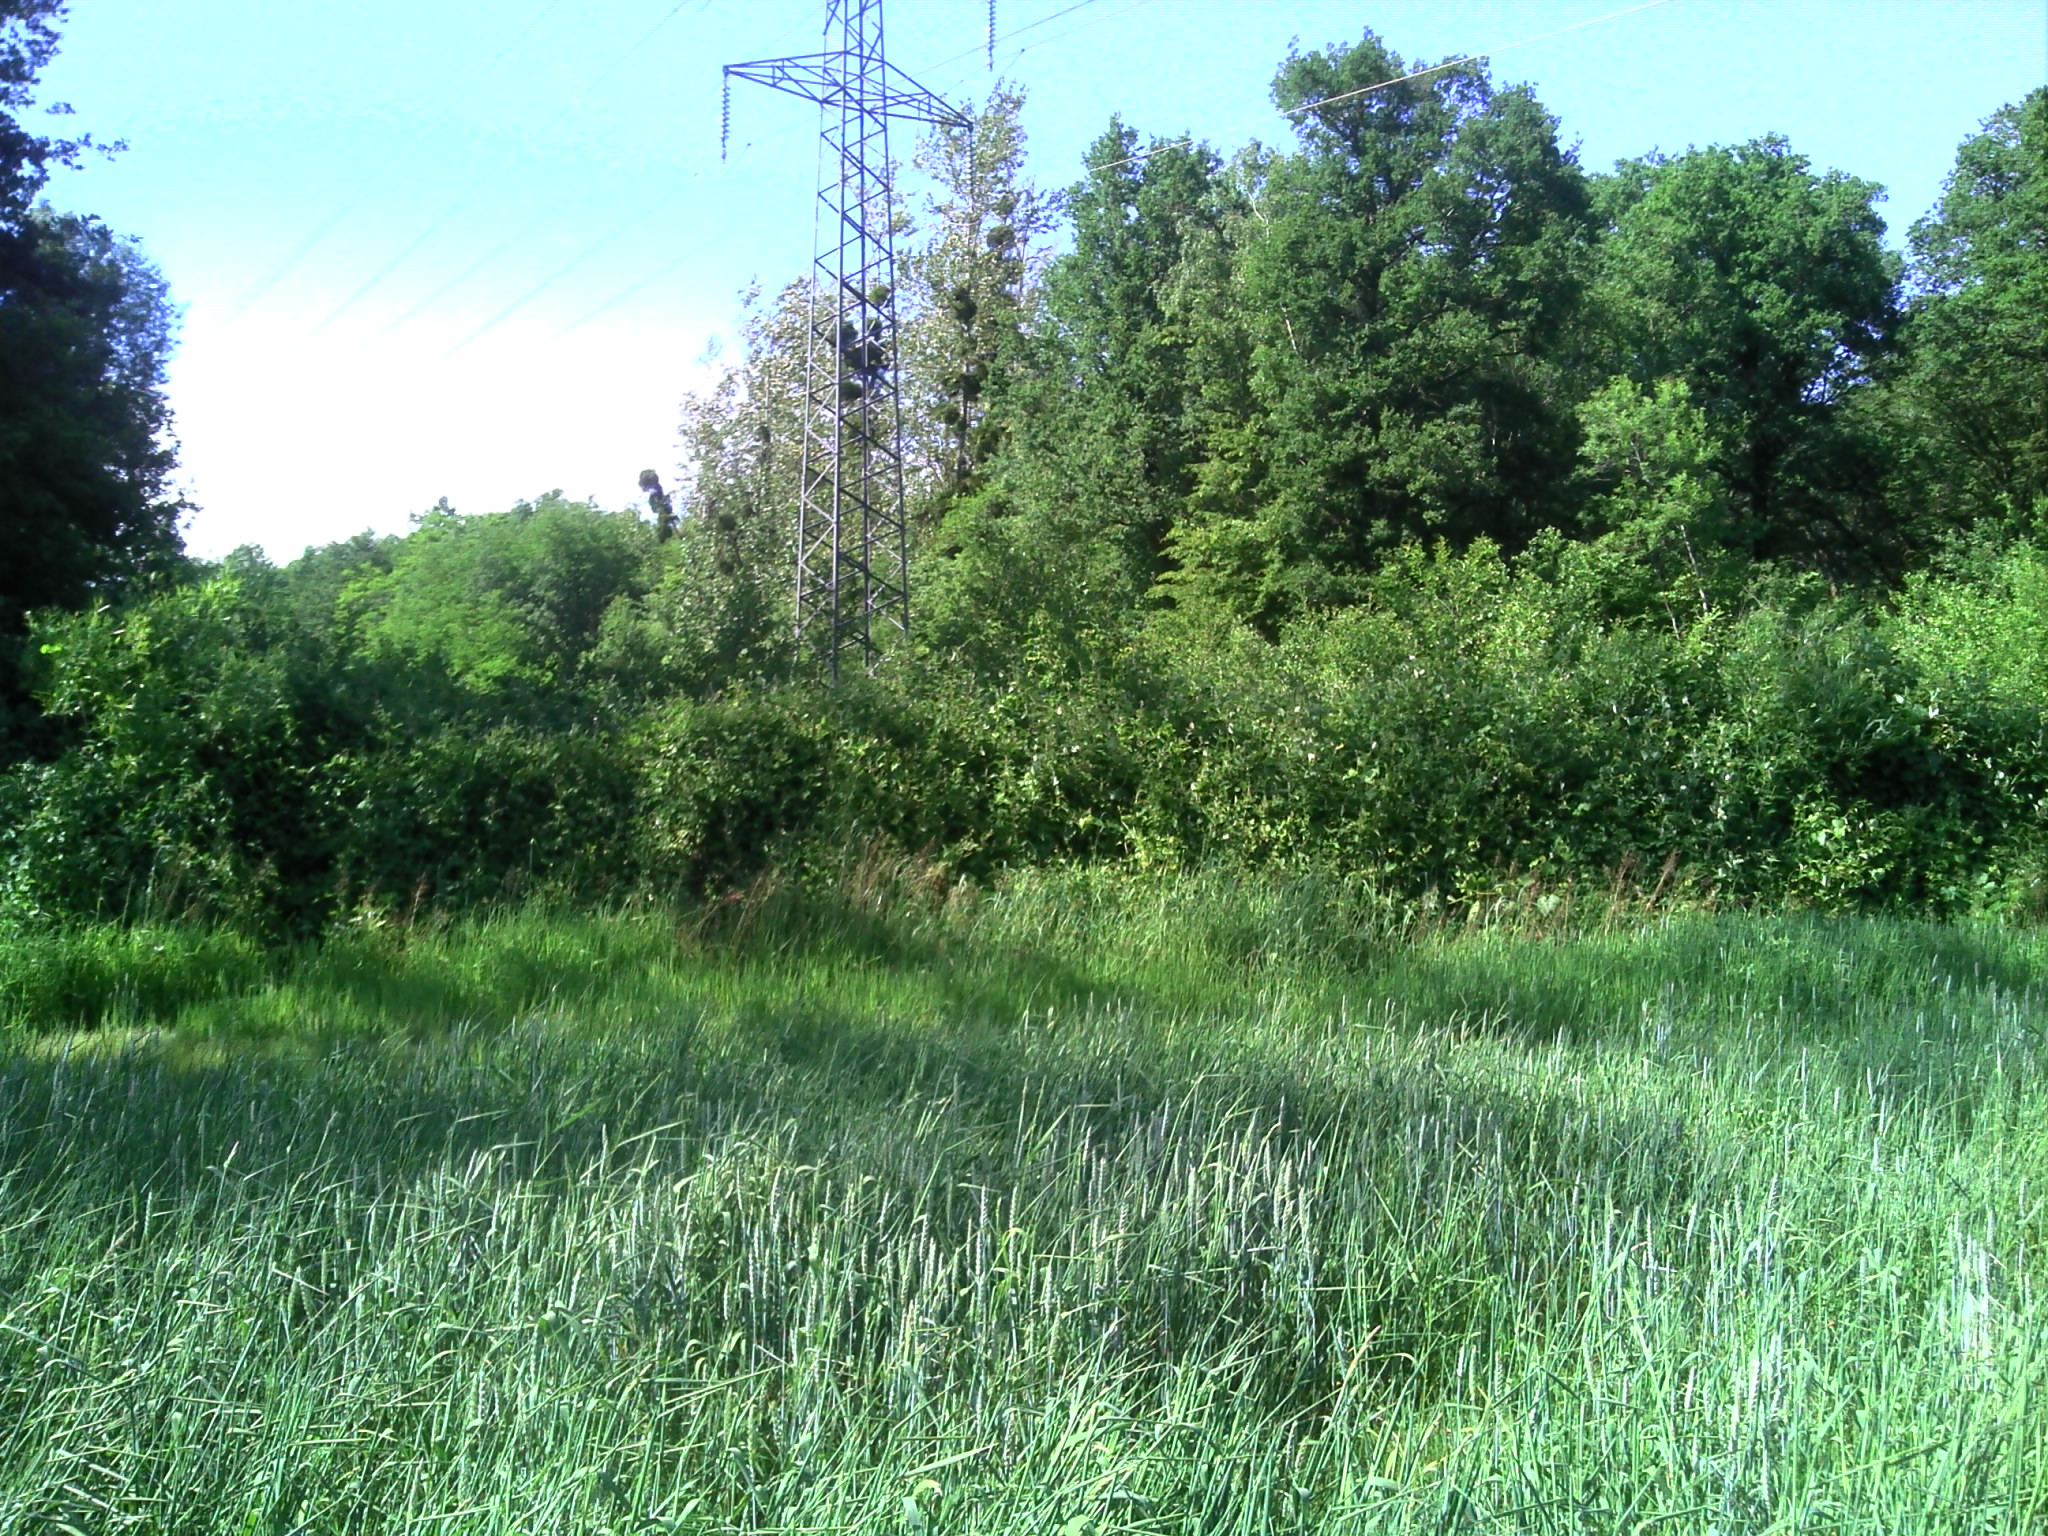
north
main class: Cropland
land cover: Common wheat
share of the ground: > 75 %
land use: Agriculture (excluding fallow land and kitchen gardens)
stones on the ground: < 10 %
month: May
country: FR
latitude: 46.5390
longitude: 4.9556
